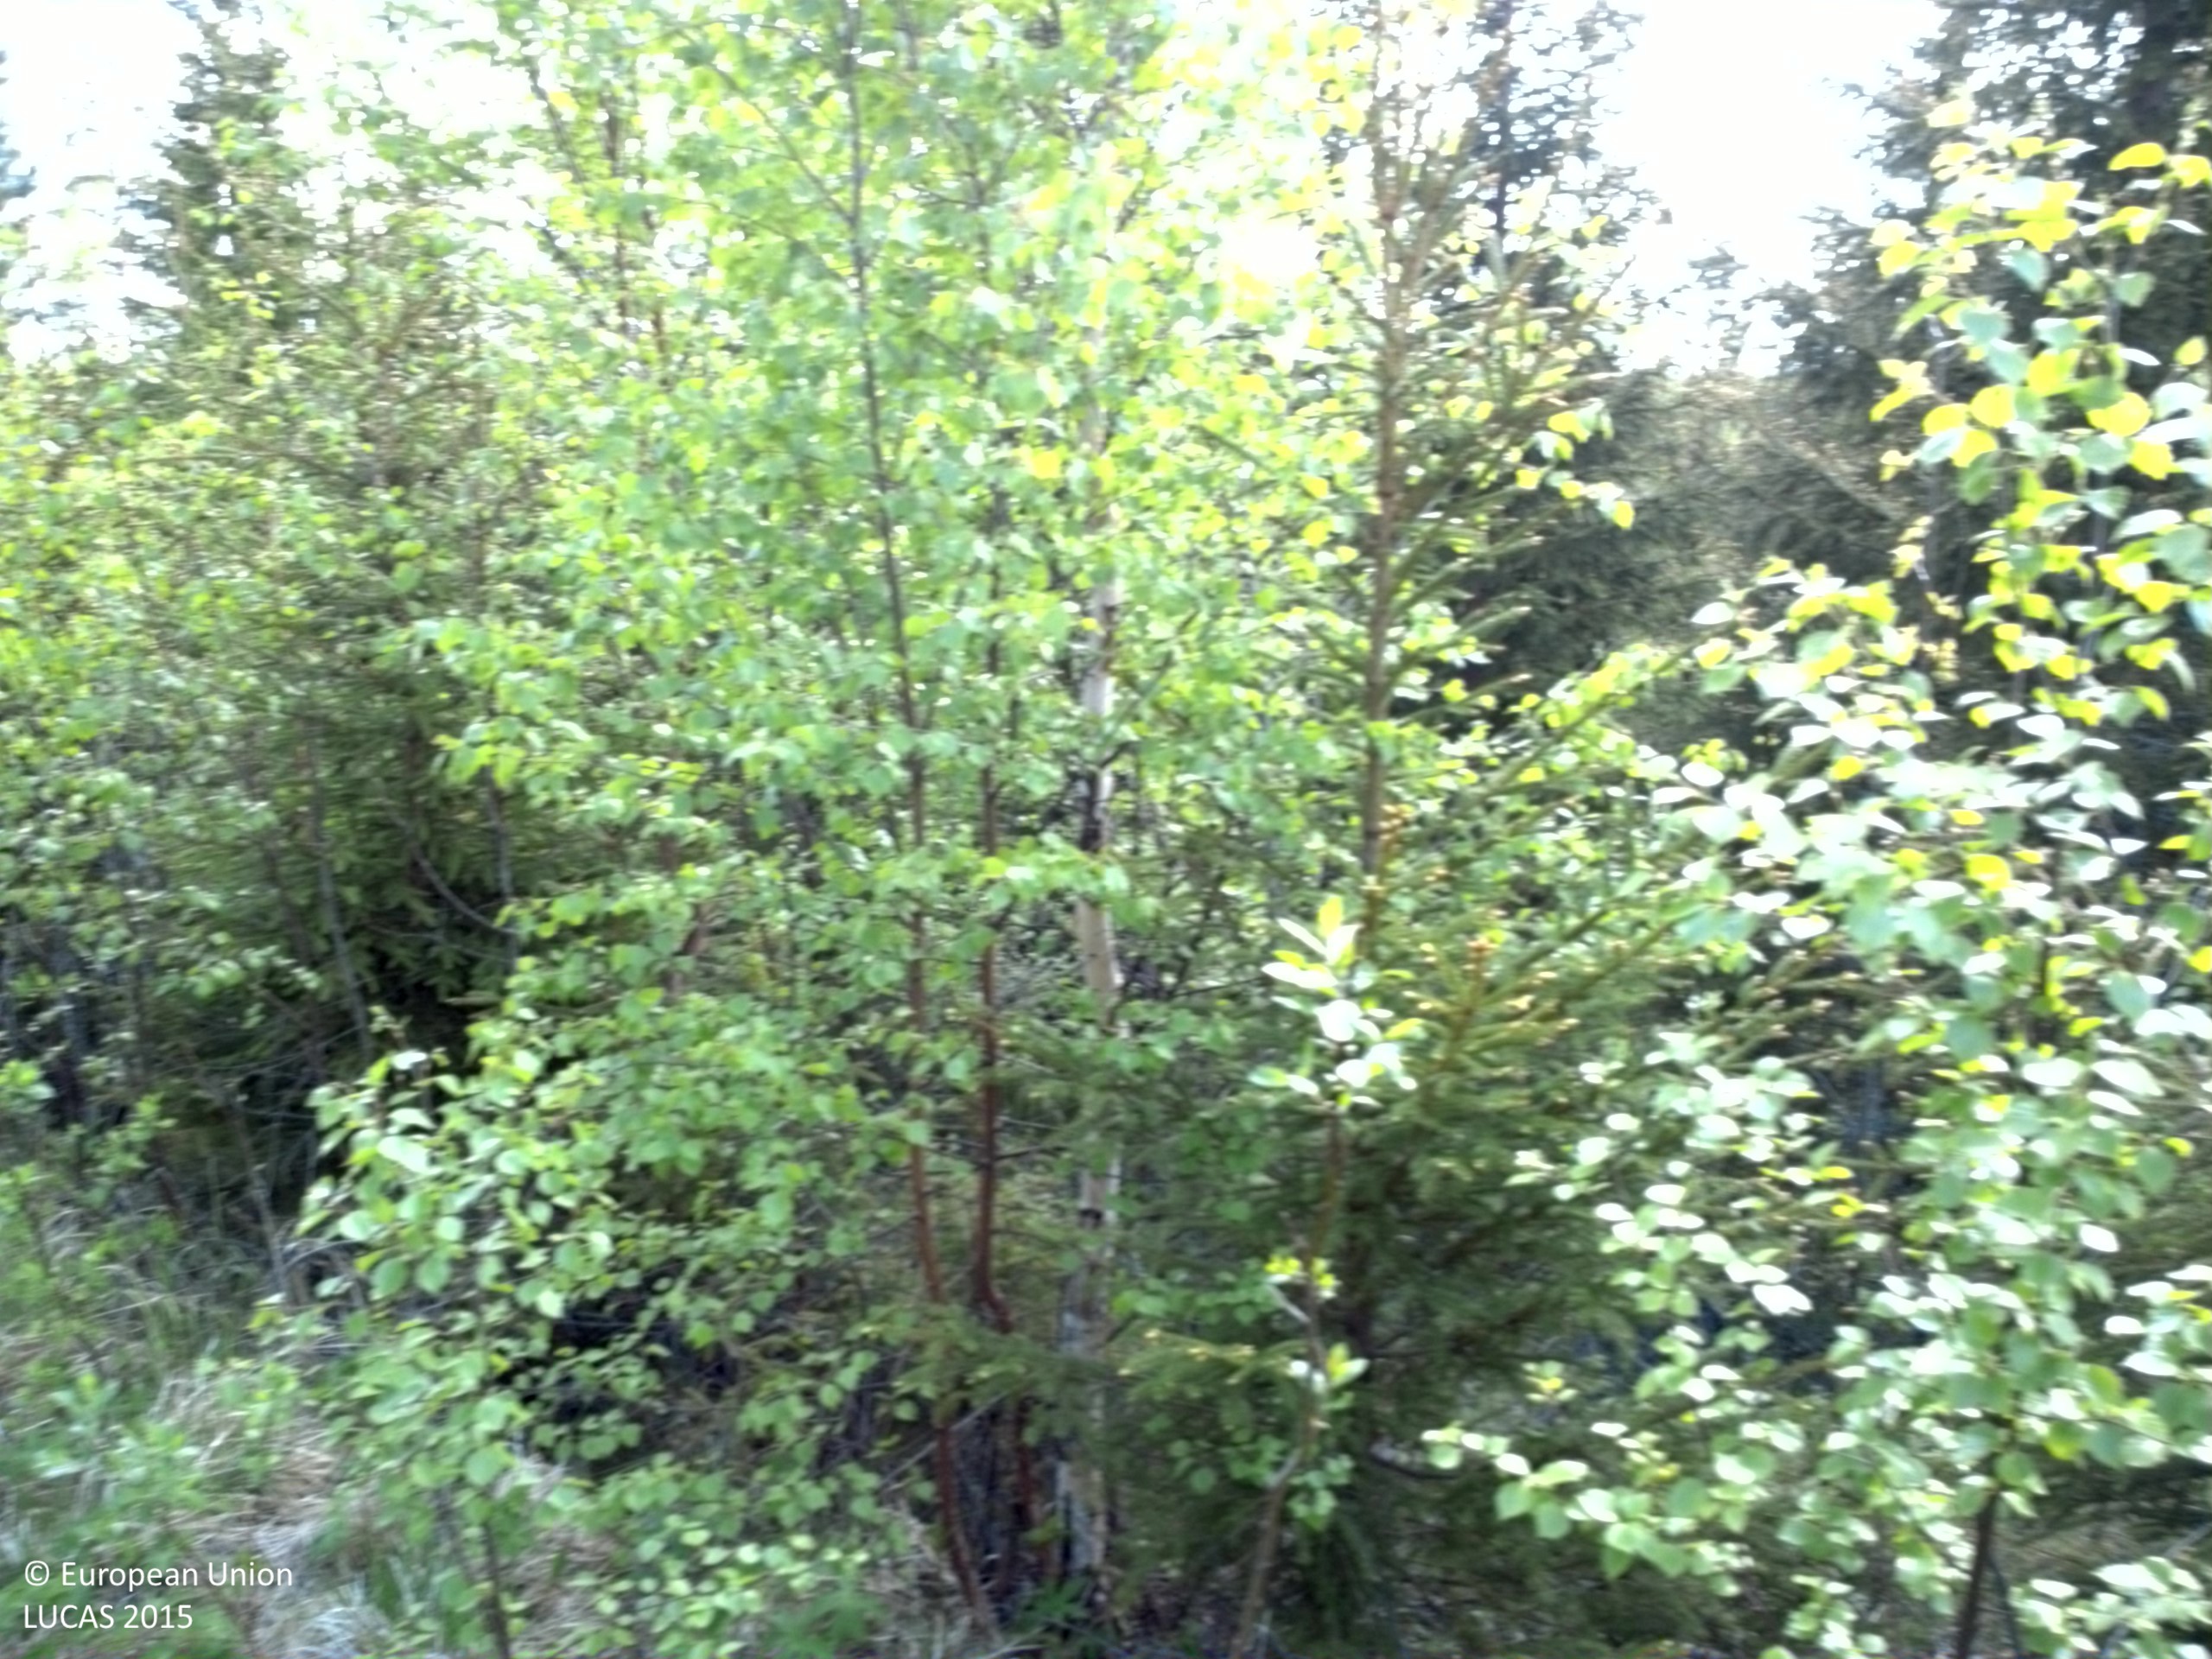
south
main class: Woodland
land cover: Spruce dominated coniferous woodland
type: boreal forest
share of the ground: 50 - 75 %
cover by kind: coniferous forest trees 70 %, herbaceous plants 30 %
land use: Forestry
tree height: > 5 m
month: June
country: SE
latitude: 63.0563
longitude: 17.1968
